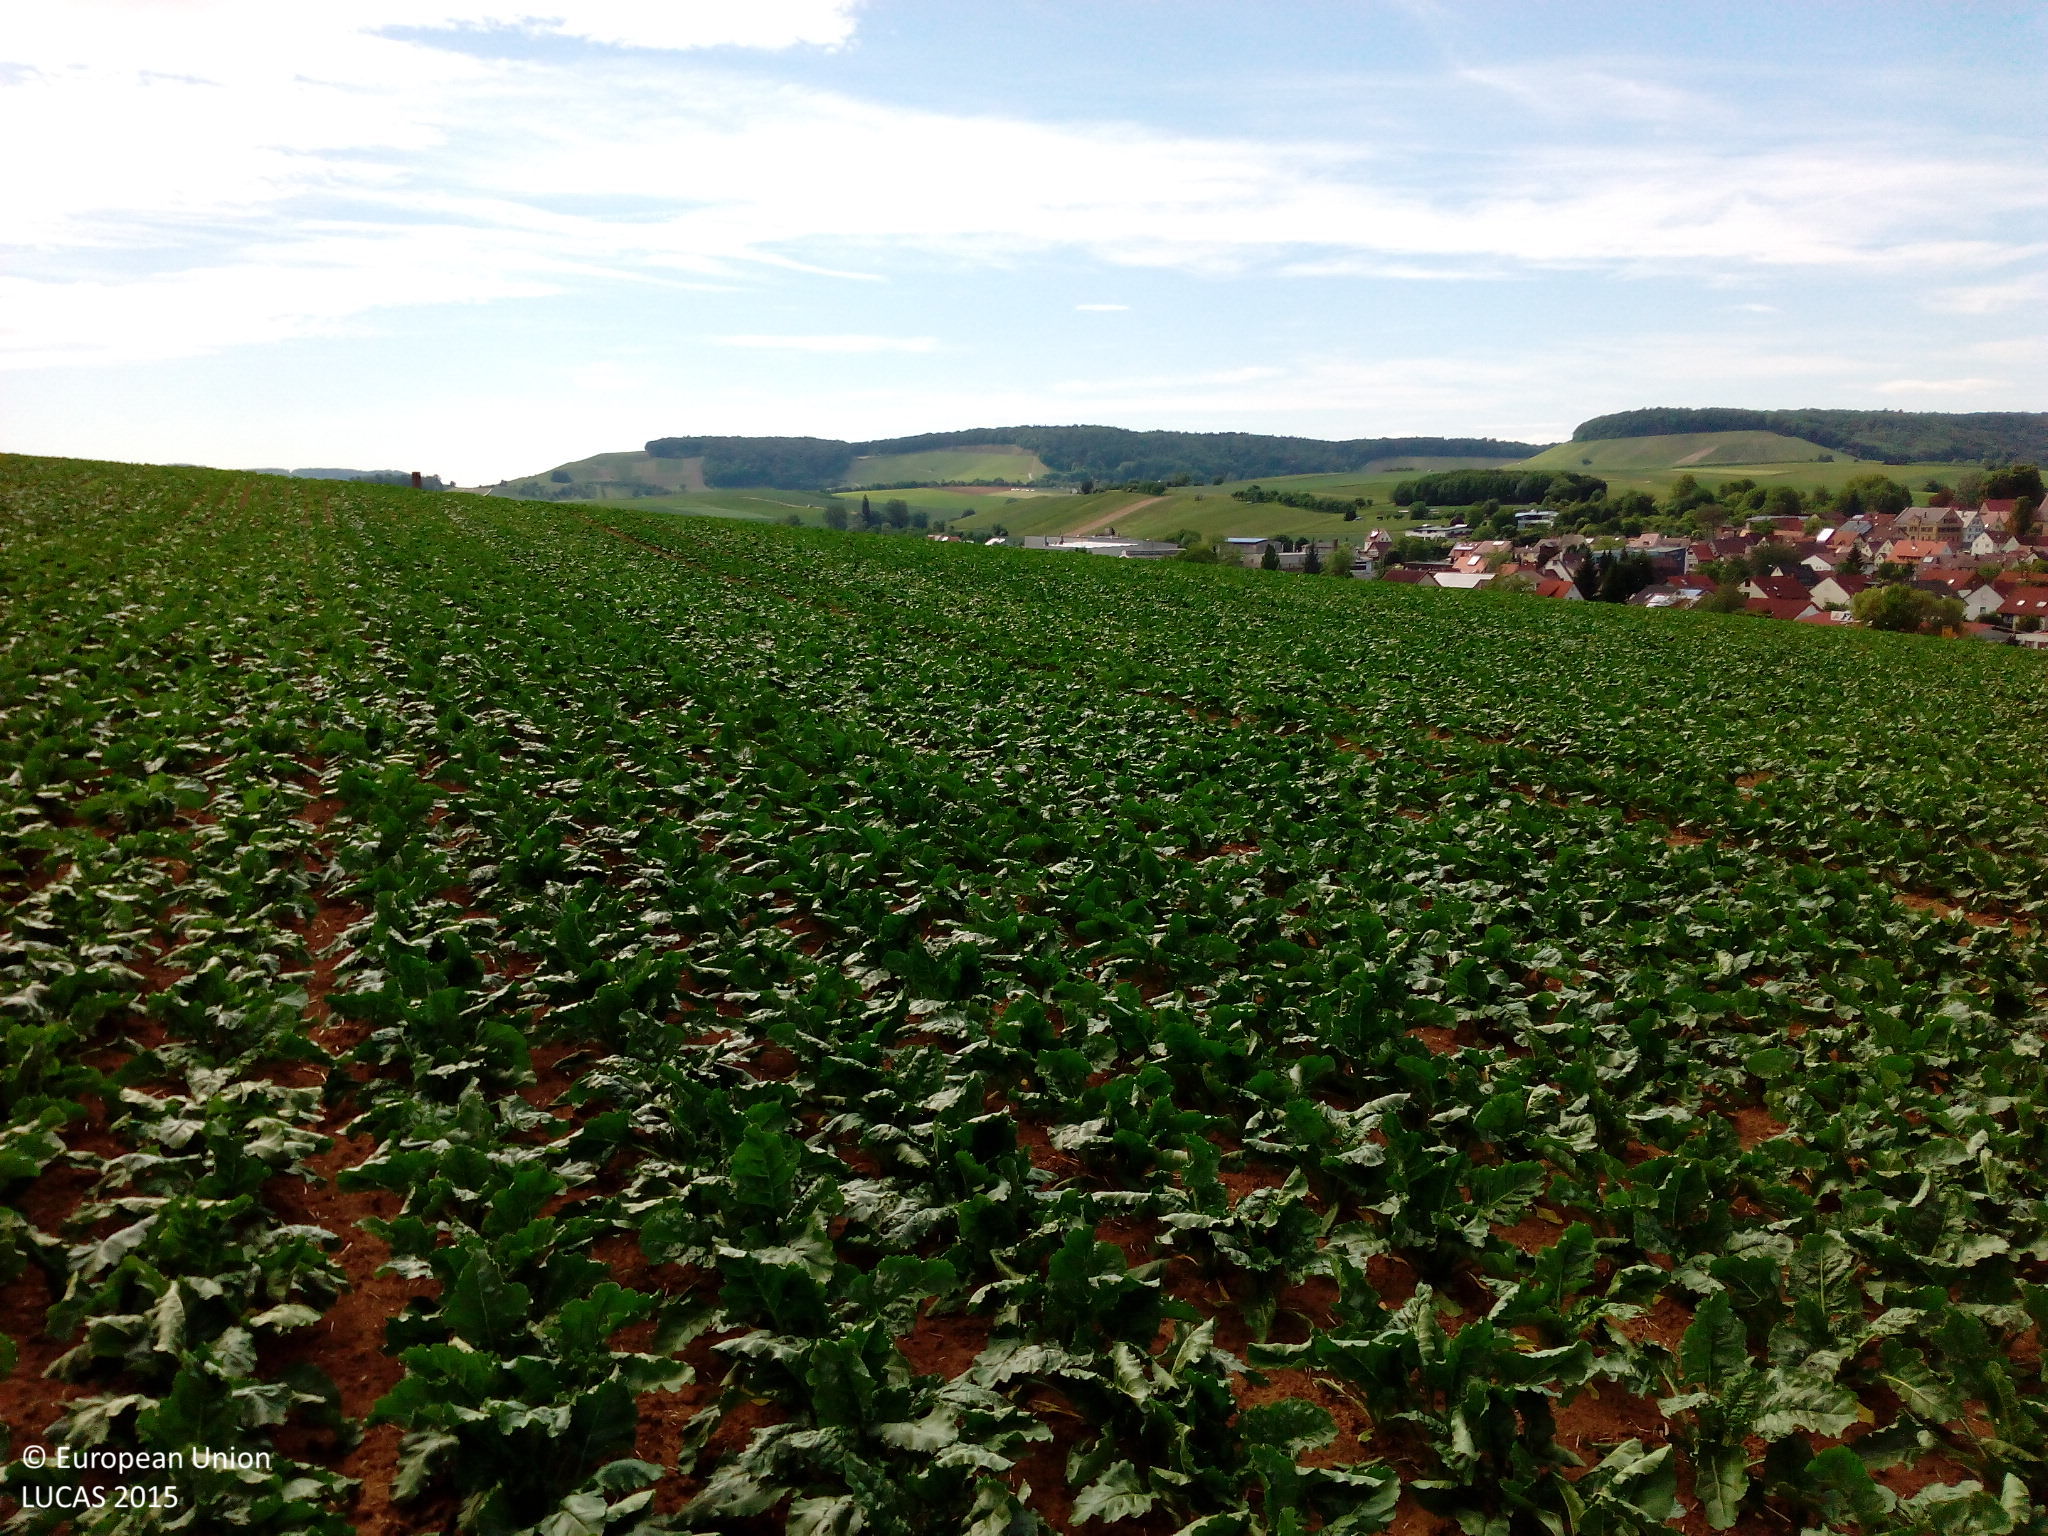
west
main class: Cropland
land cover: Sugar beet
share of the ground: > 75 %
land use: Agriculture (excluding fallow land and kitchen gardens)
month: June
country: DE
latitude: 49.1751
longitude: 9.3281
